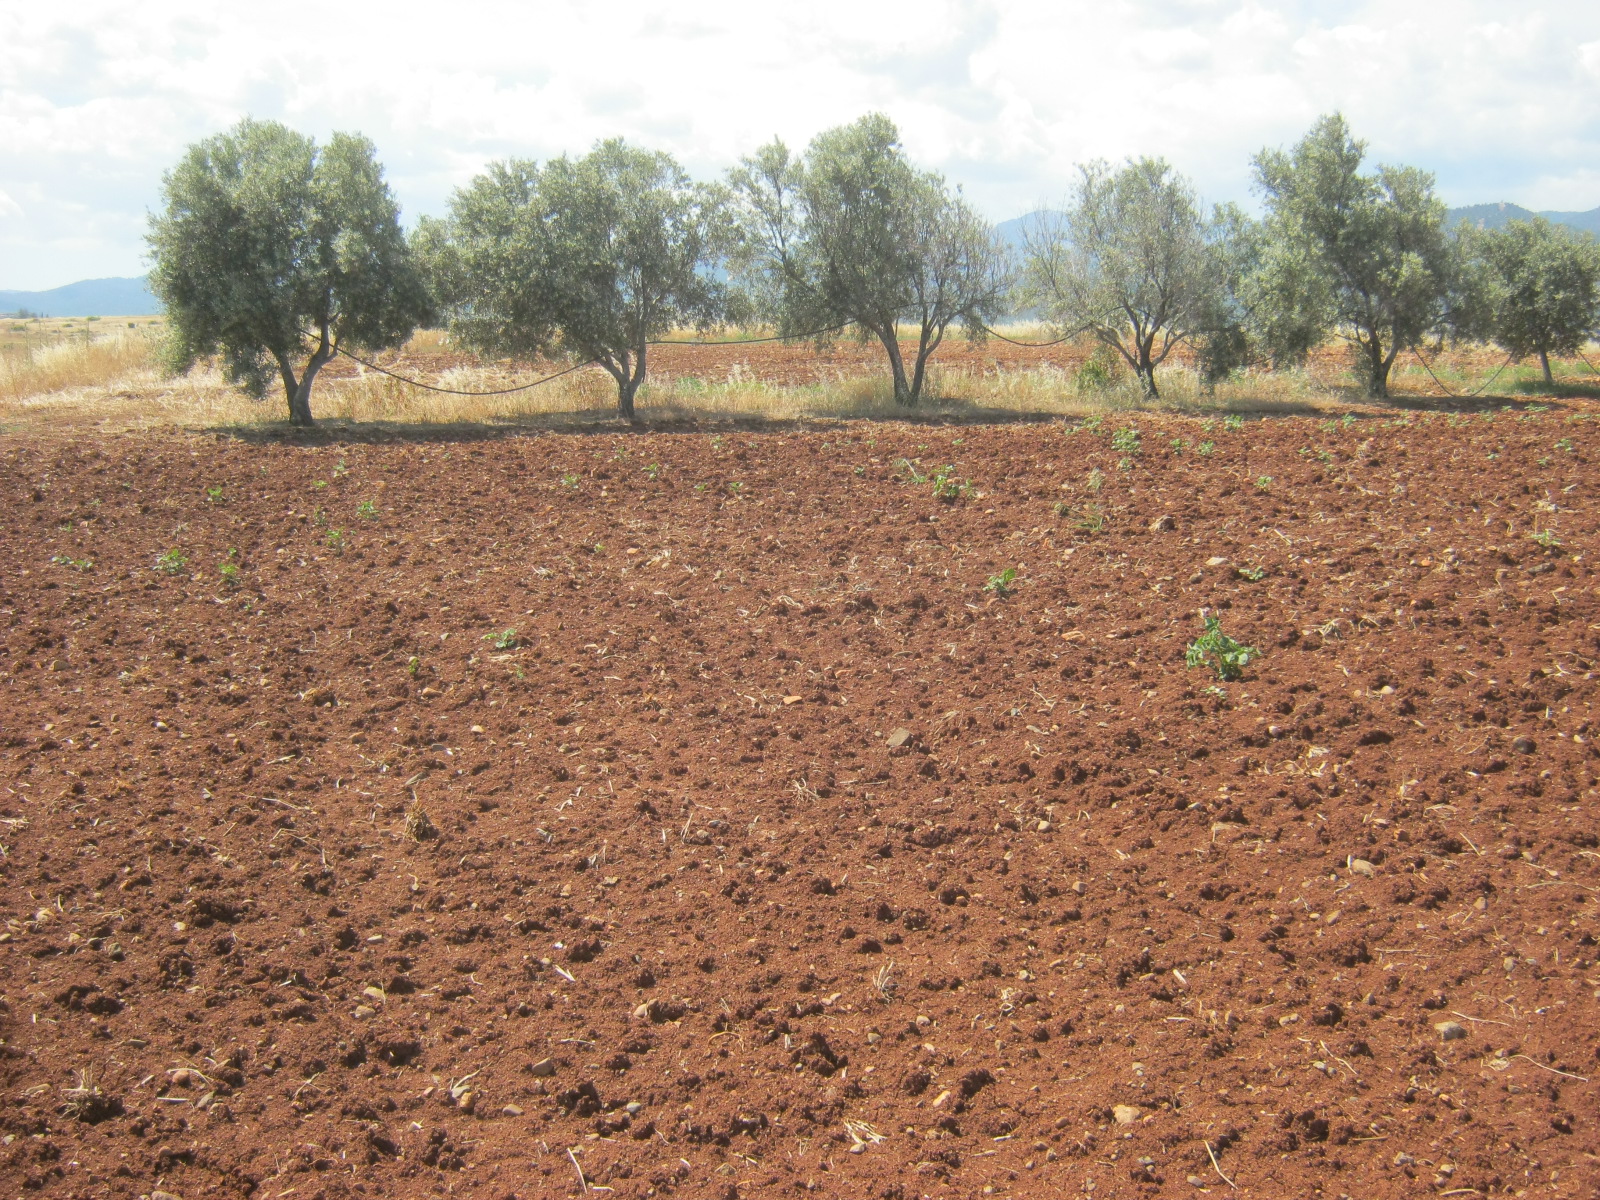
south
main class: Cropland
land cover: Potatoes
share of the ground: < 10 %
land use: Agriculture (excluding fallow land and kitchen gardens)
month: May
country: CY
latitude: 35.0930
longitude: 33.0040
